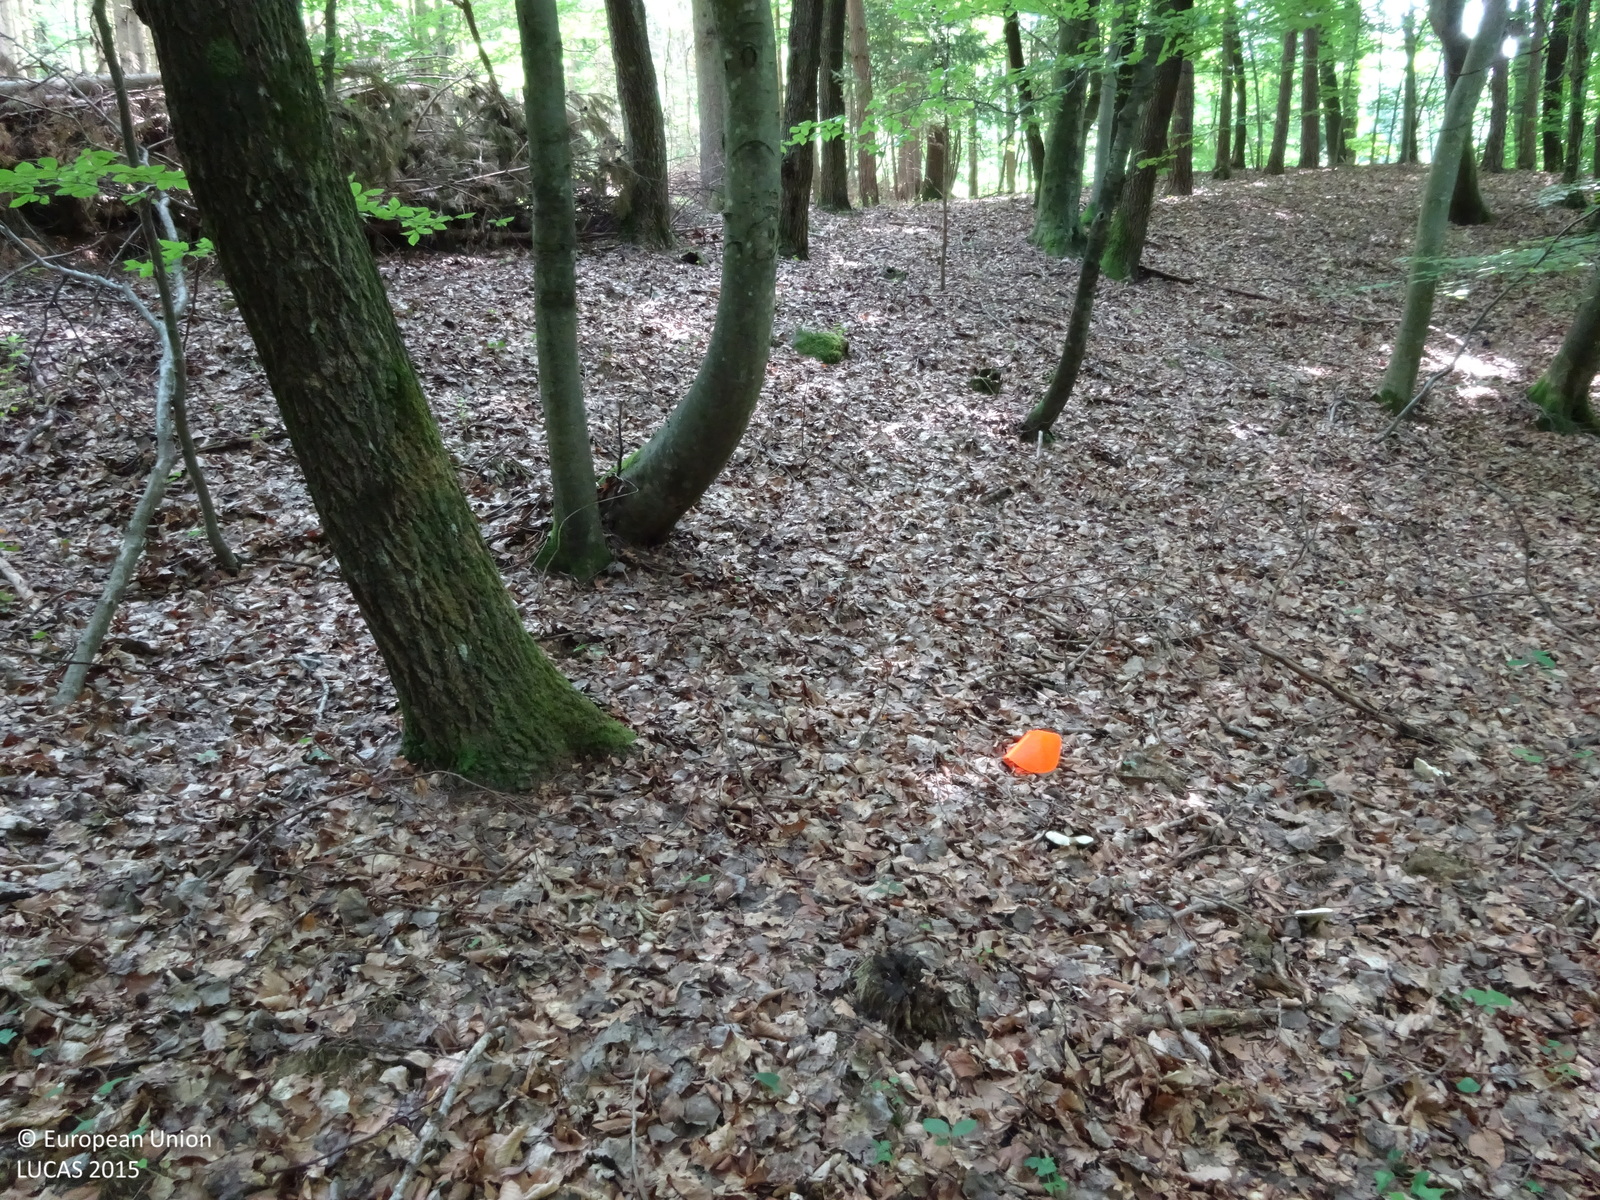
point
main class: Woodland
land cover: Pine dominated mixed woodland
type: hemiboreal forest and nemoral coniferous forest and mixed broadleaved-coniferous forest
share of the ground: > 75 %
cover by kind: broadleaved forest trees 75 %, coniferous forest trees 25 %
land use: Forestry
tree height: > 5 m
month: June
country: AT
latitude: 46.8541
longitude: 15.9418
